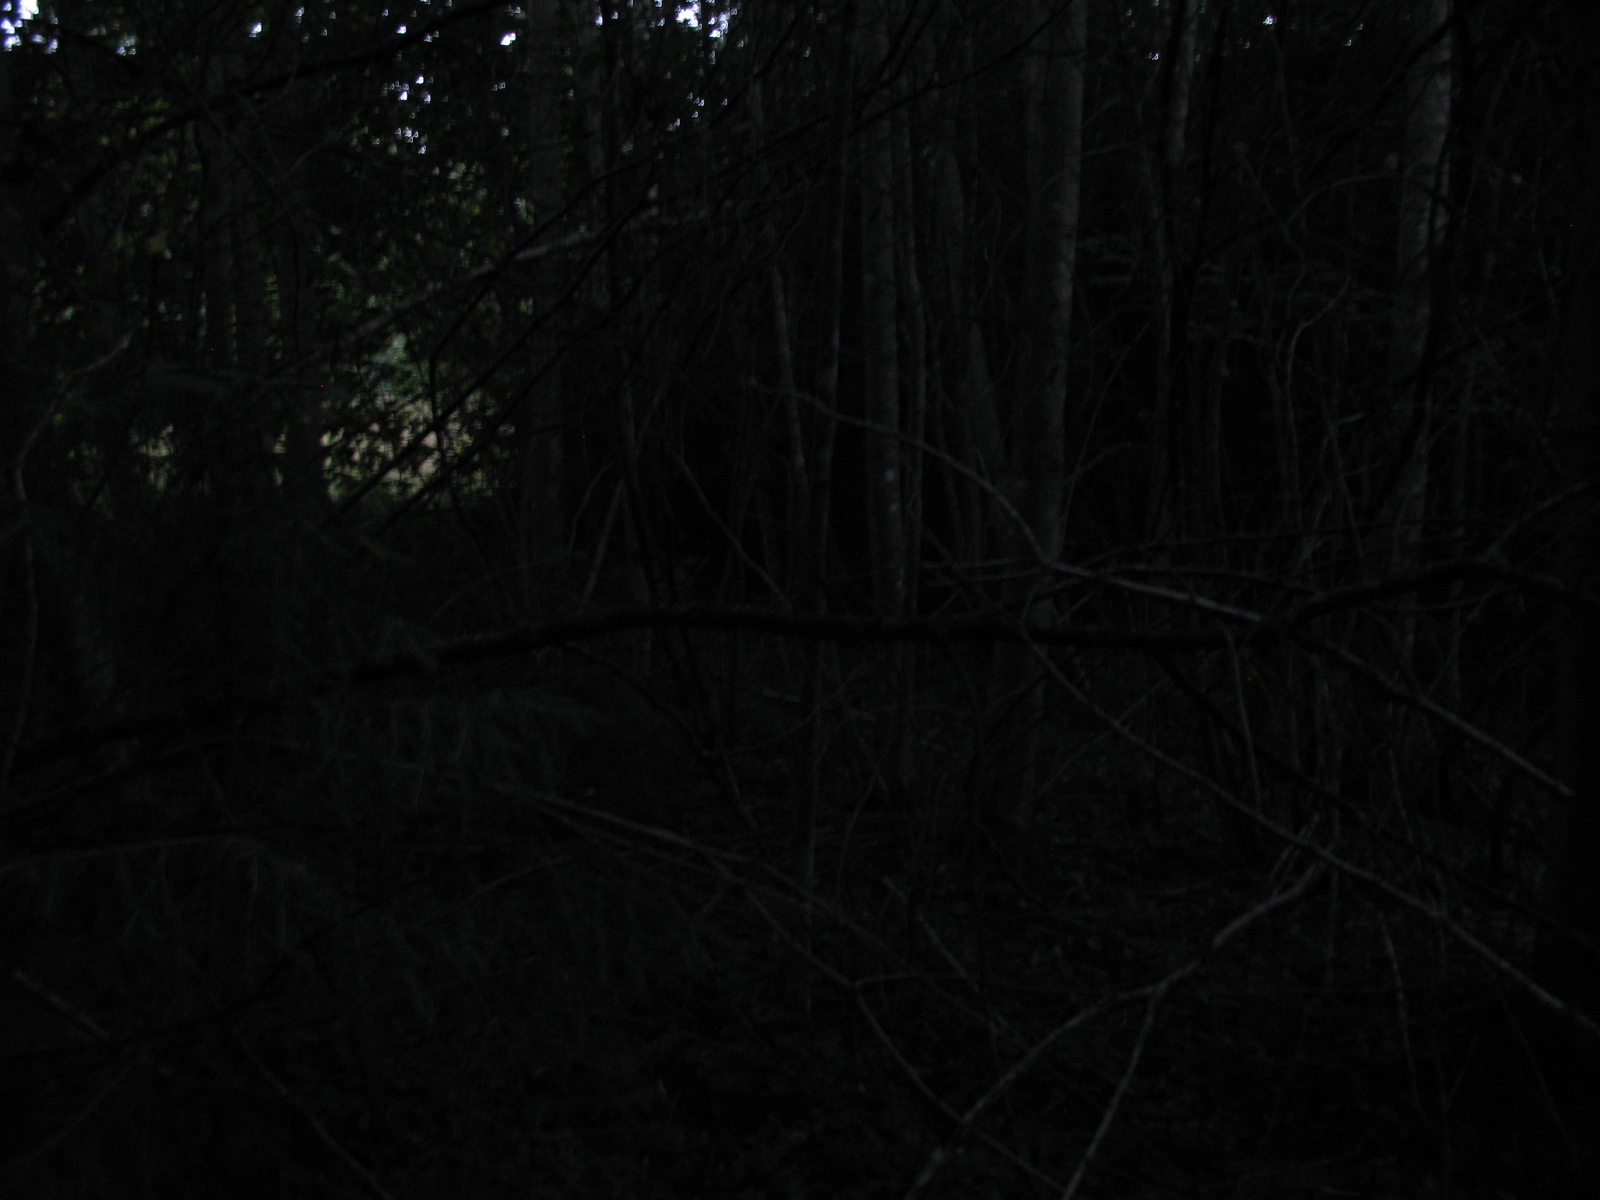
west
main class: Woodland
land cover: Broadleaved woodland
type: non-riverine alder, birch or aspen forest
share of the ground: > 75 %
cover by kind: broadleaved forest trees 90 %, unconsolidated bare surface 5 %
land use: Forestry
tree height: > 5 m
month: August
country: LV
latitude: 56.4702
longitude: 25.6257
